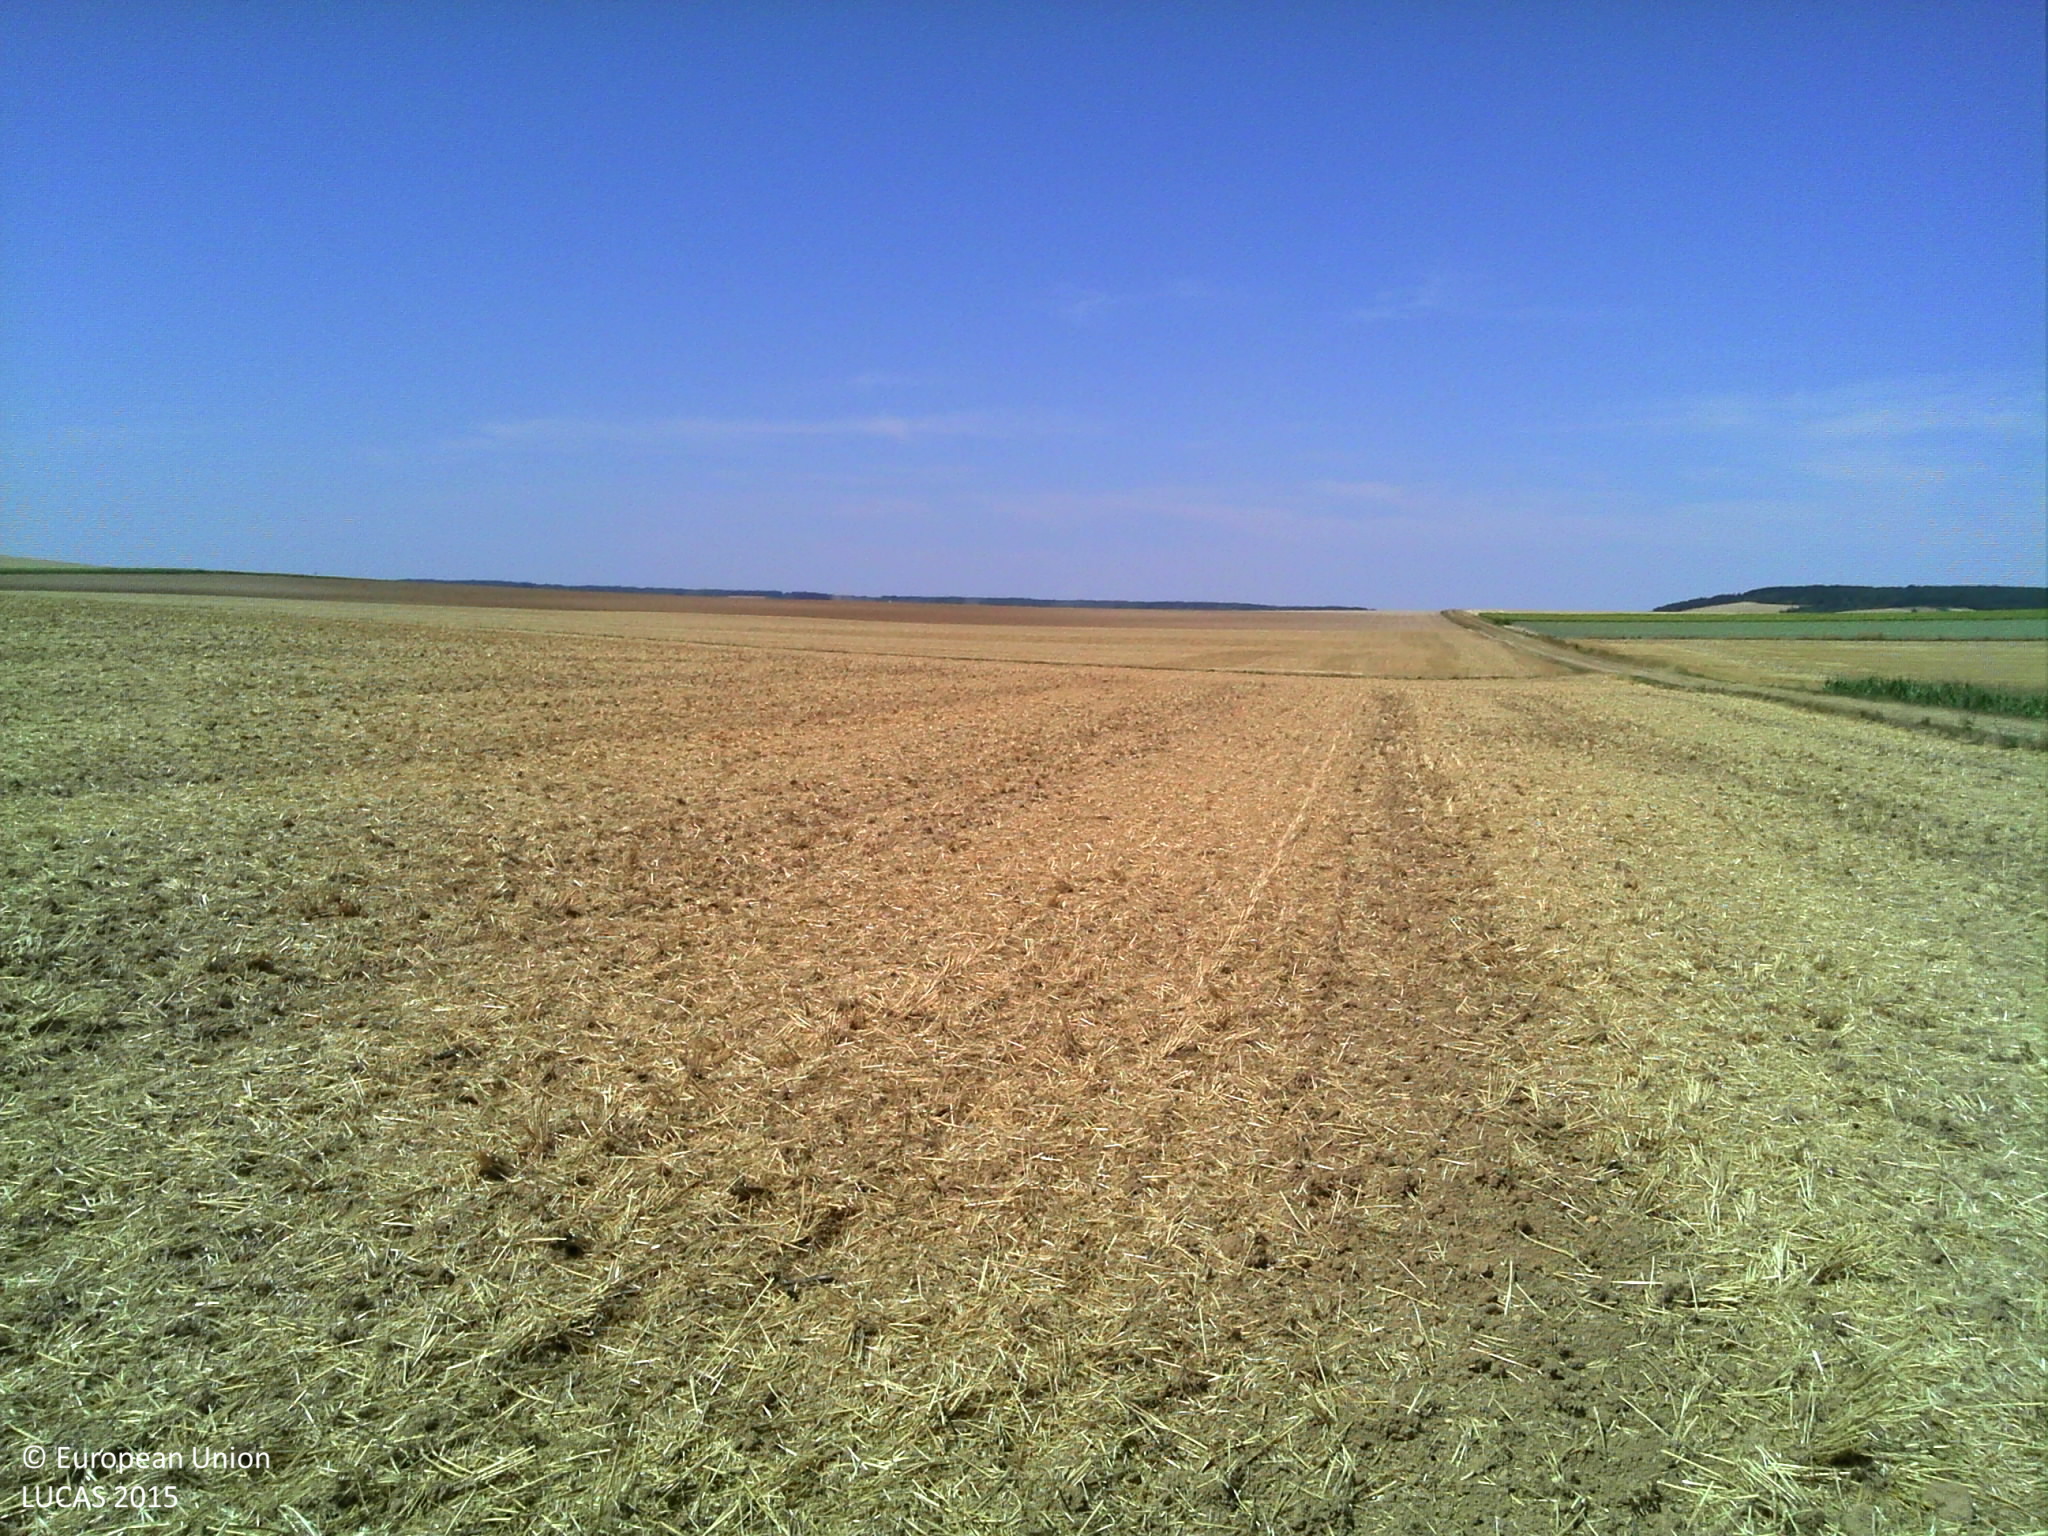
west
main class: Cropland
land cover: Common wheat
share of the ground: > 75 %
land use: Agriculture (excluding fallow land and kitchen gardens)
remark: Tilled/Sowed
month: August
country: FR
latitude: 47.9189
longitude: 3.4245
